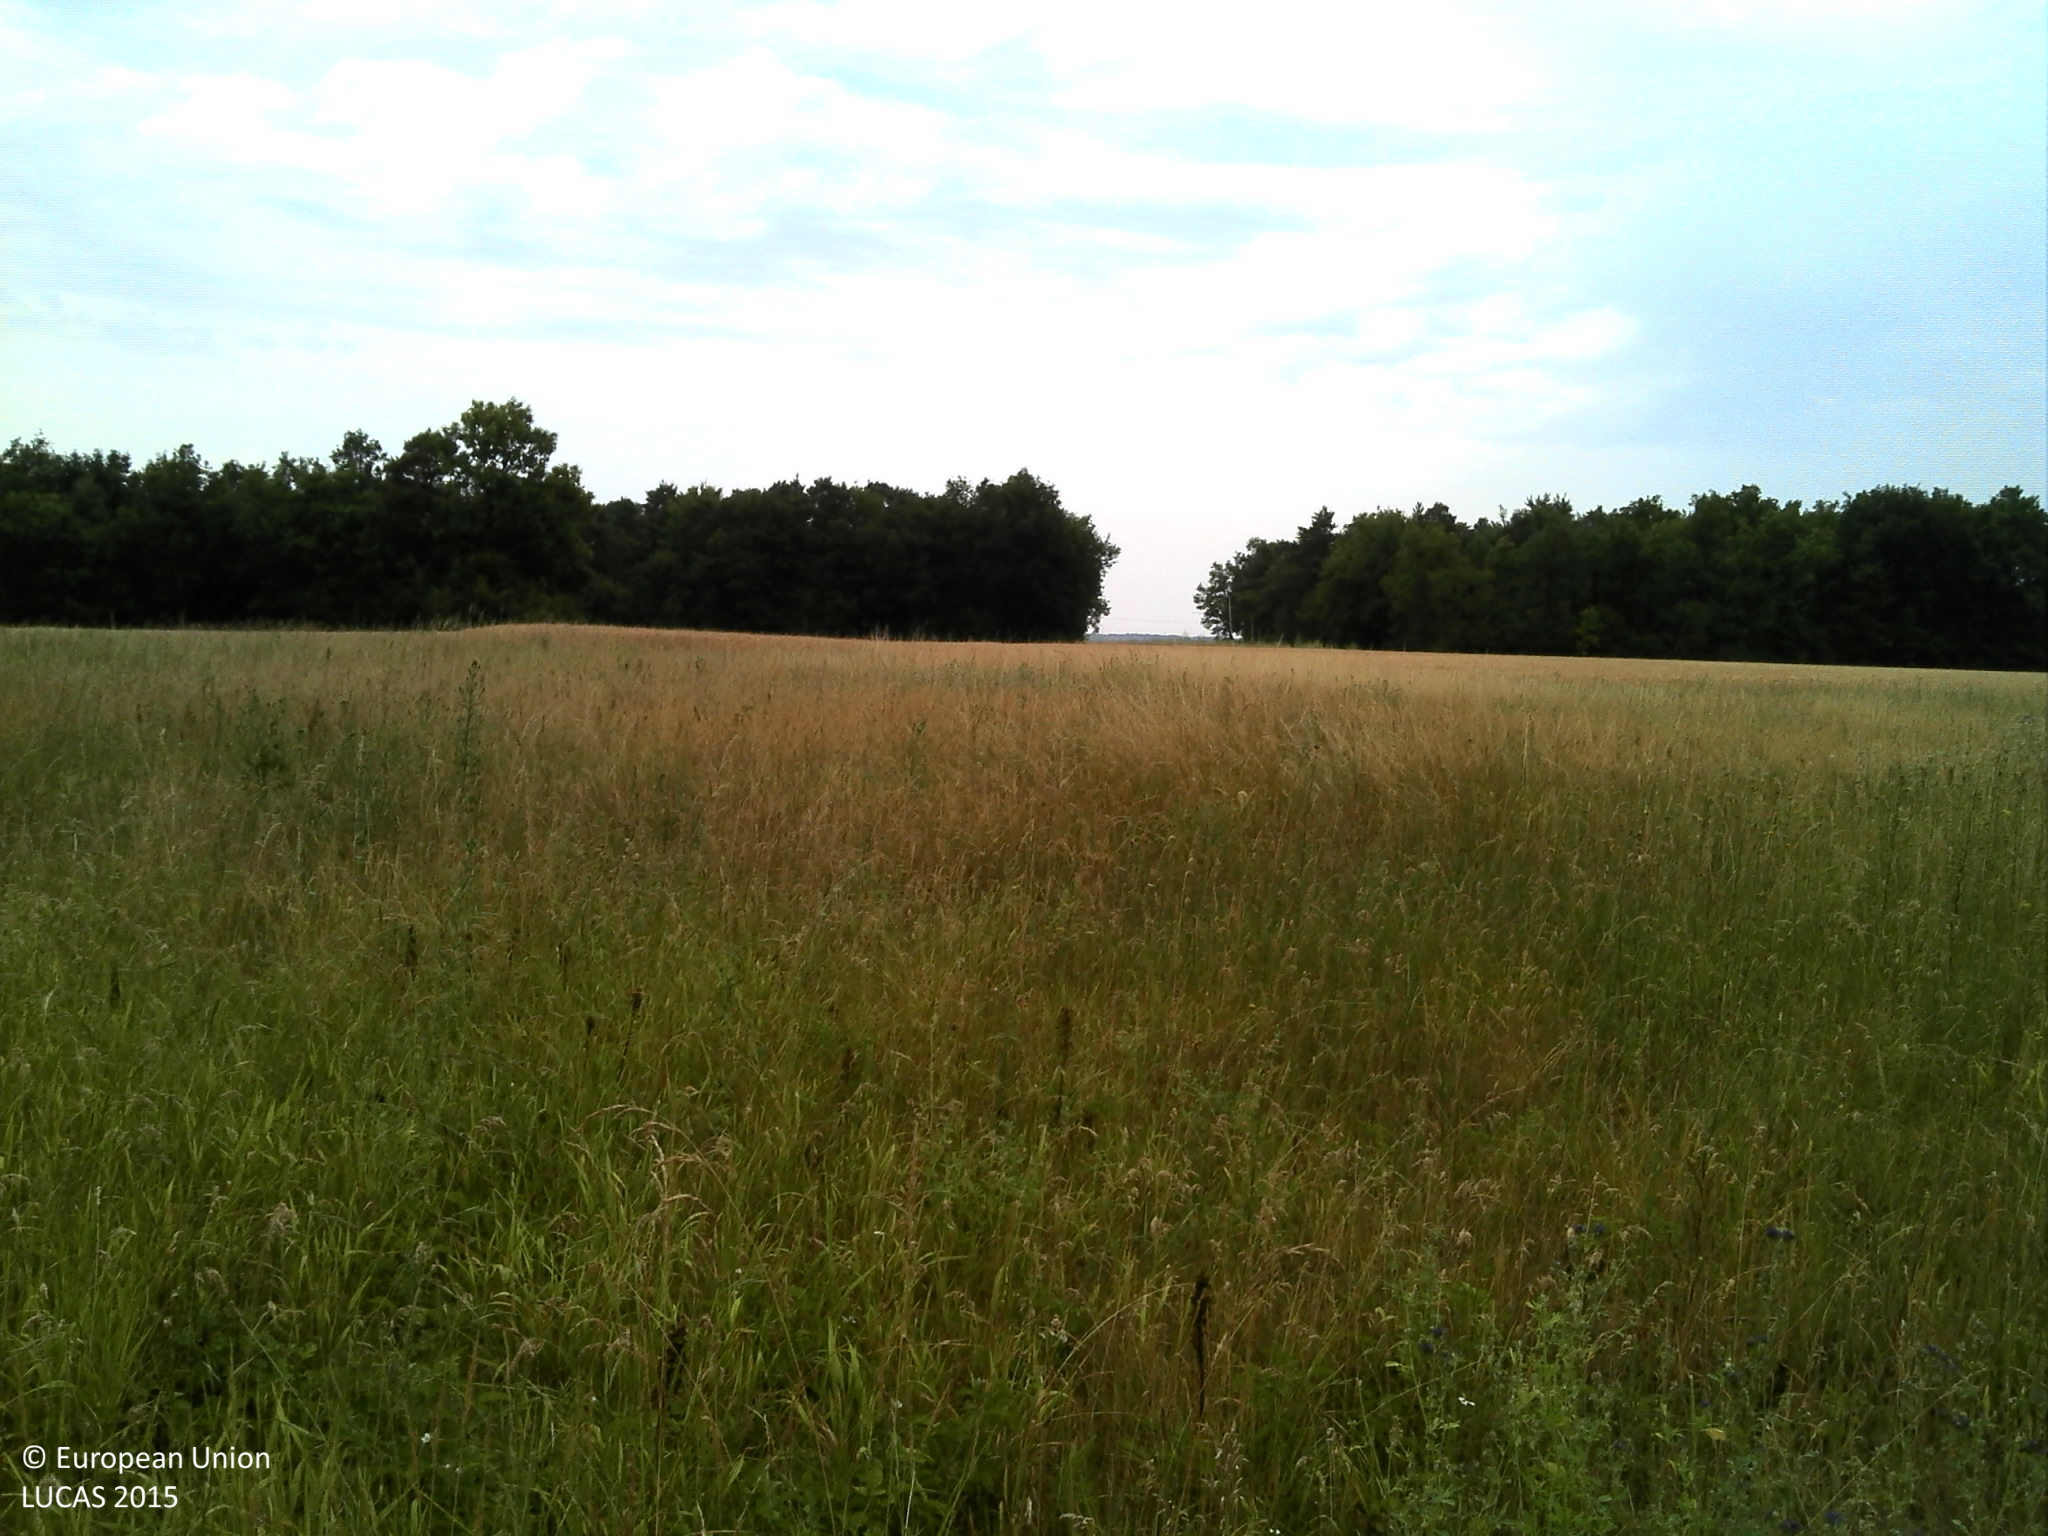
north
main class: Grassland
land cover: Grassland without tree/shrub cover
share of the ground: > 75 %
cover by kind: herbaceous plants 100 %
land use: Agriculture (excluding fallow land and kitchen gardens)
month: July
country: FR
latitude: 48.2543
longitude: 2.4606
